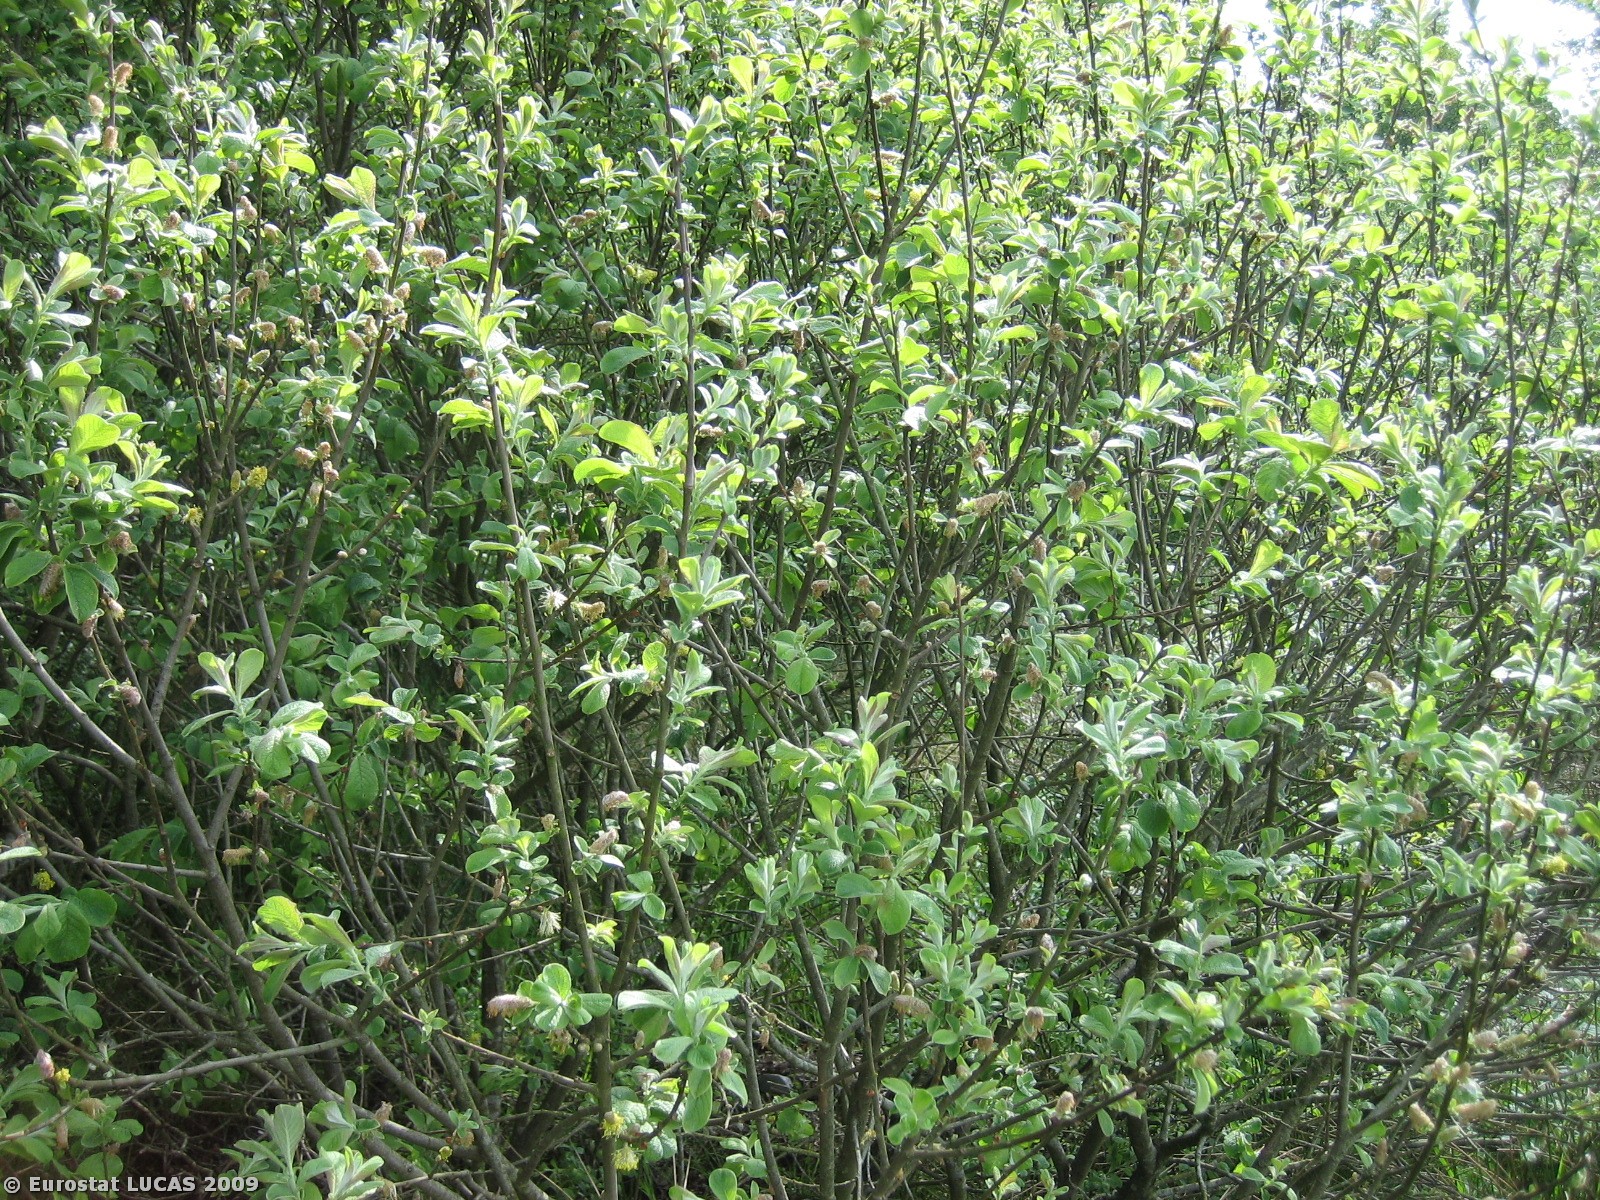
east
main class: Shrubland
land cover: Shrubland with sparse tree cover
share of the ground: > 75 %
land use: Unused
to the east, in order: Shrubland with sparse tree cover; Broadleaved woodland; Ditches and canals; Grassland with sparse tree/shrub cover; Broadleaved woodland; Grassland with sparse tree/shrub cover; Grassland without tree/shrub cover; Ditches and canals; Grass margins; Barley
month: May
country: DK
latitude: 56.0928
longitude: 8.8601
